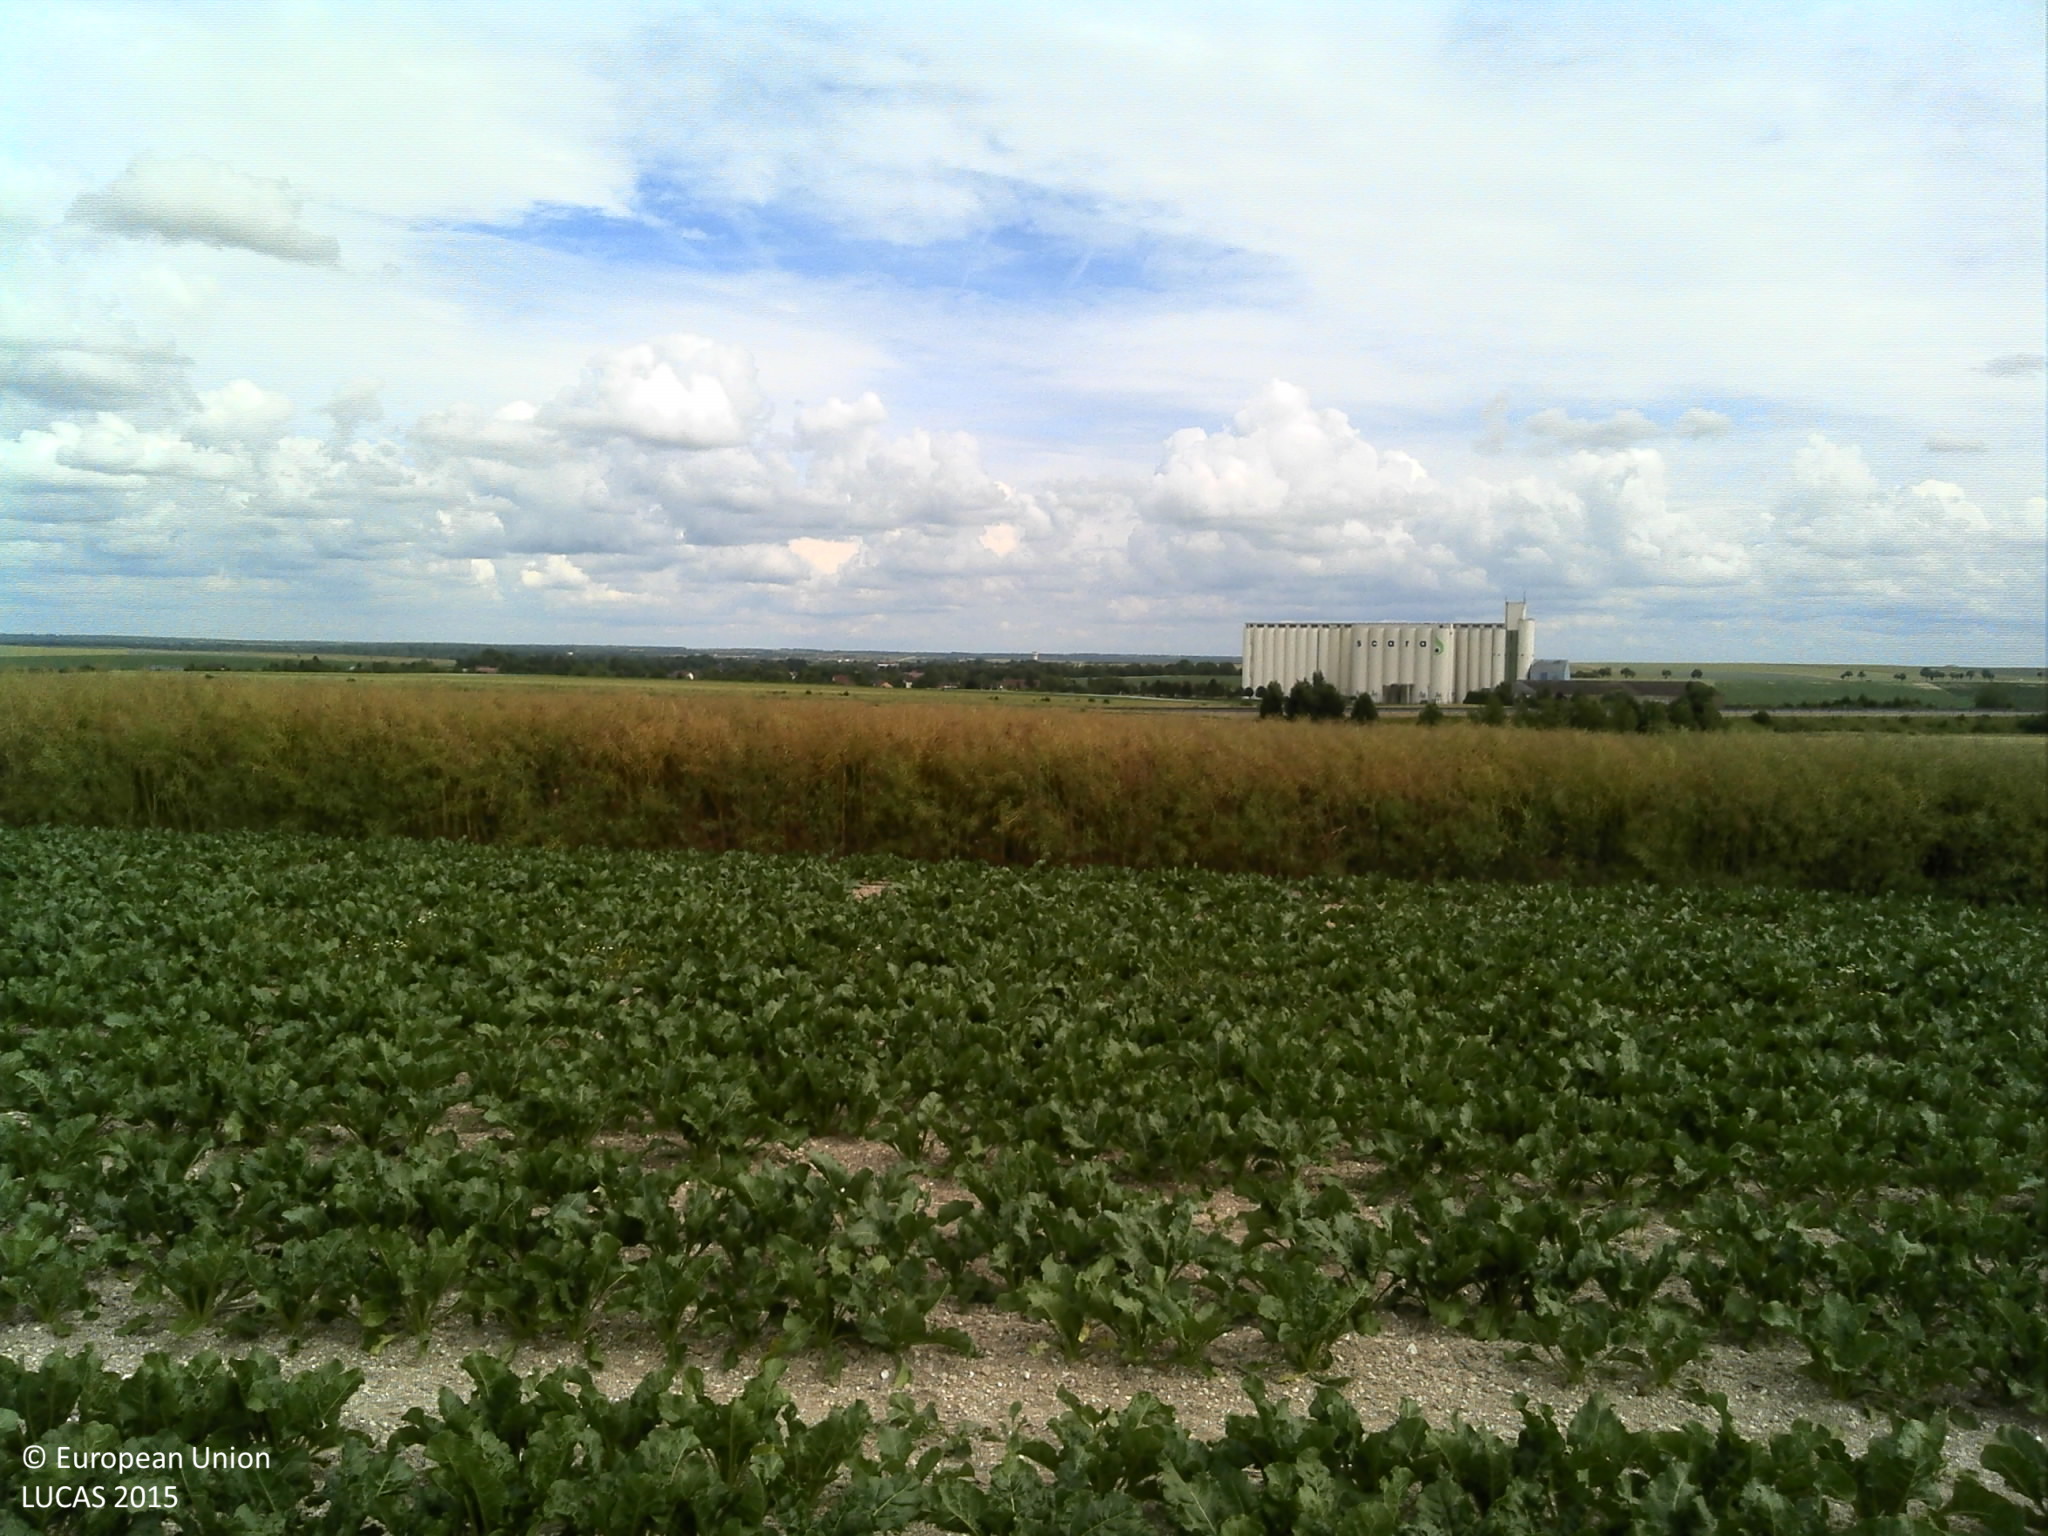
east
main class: Cropland
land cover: Sugar beet
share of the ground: 50 - 75 %
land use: Agriculture (excluding fallow land and kitchen gardens)
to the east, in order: Sugar beet; Rape and turnip rape; Barley
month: June
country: FR
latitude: 48.6826
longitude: 4.1691
